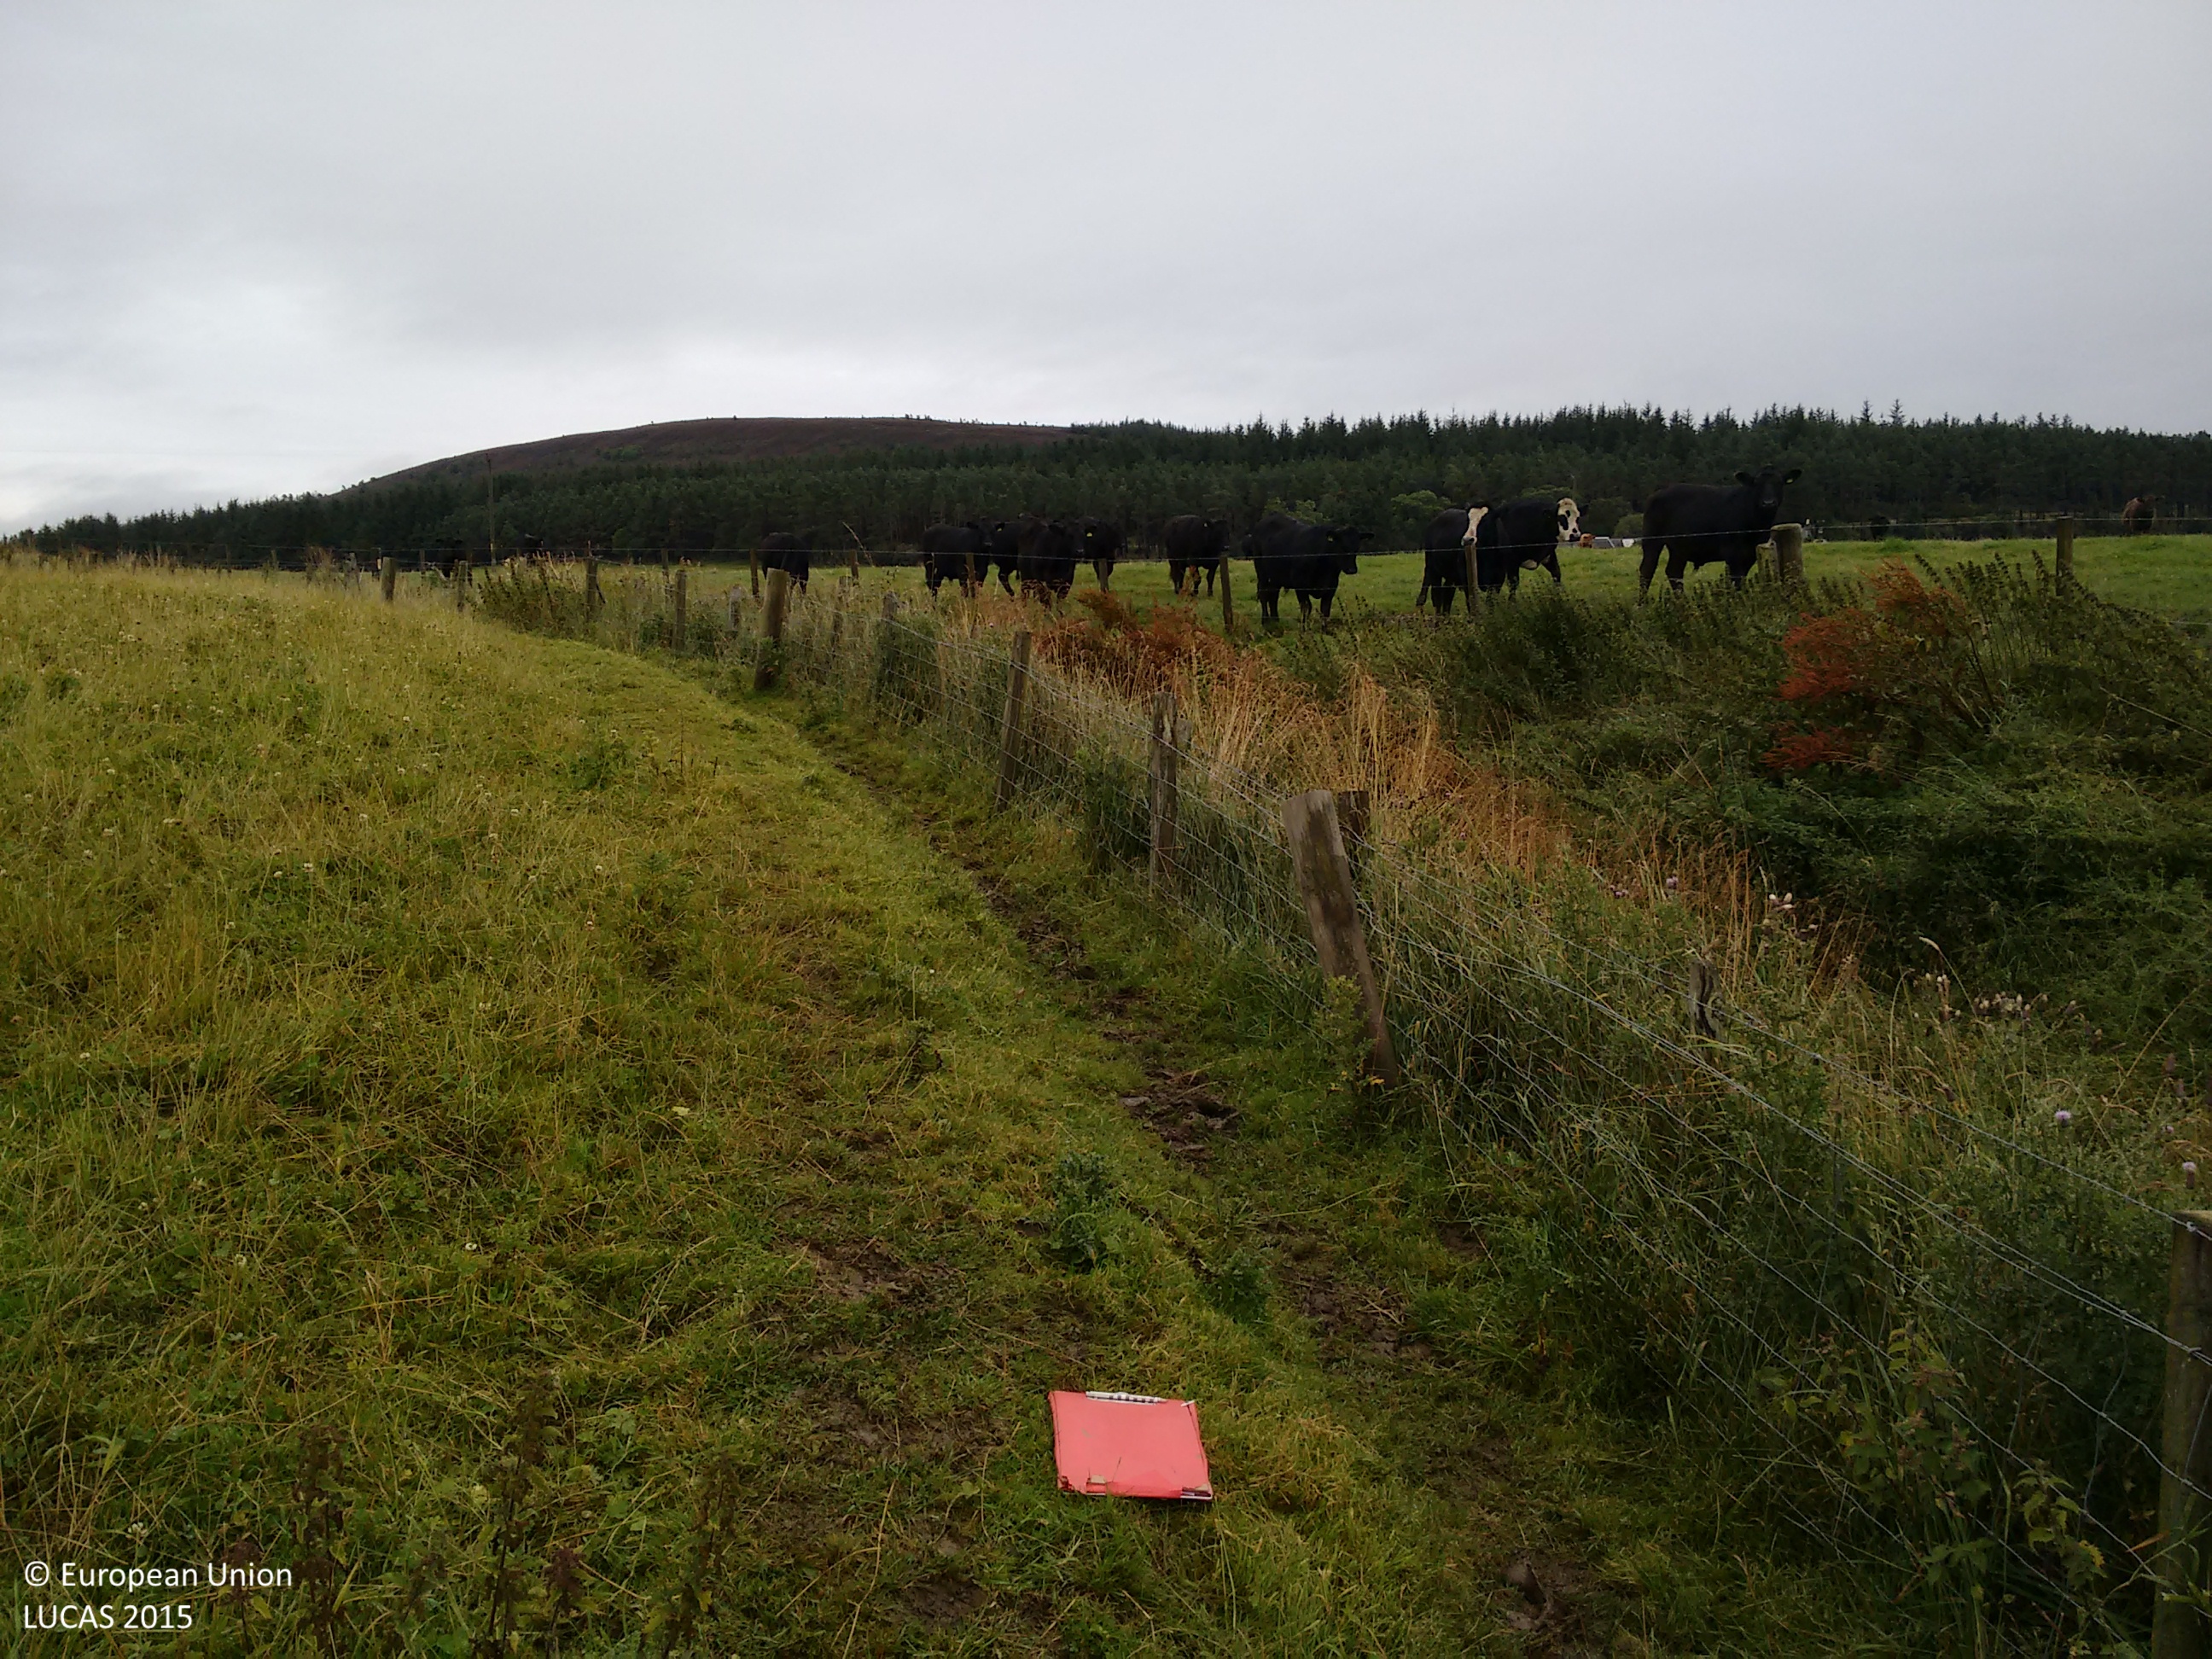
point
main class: Grassland
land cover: Grassland without tree/shrub cover
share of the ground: > 75 %
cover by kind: herbaceous plants 95 %, unconsolidated bare surface 5 %
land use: Agriculture (excluding fallow land and kitchen gardens)
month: September
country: GB
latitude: 57.5391
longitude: -2.9055
